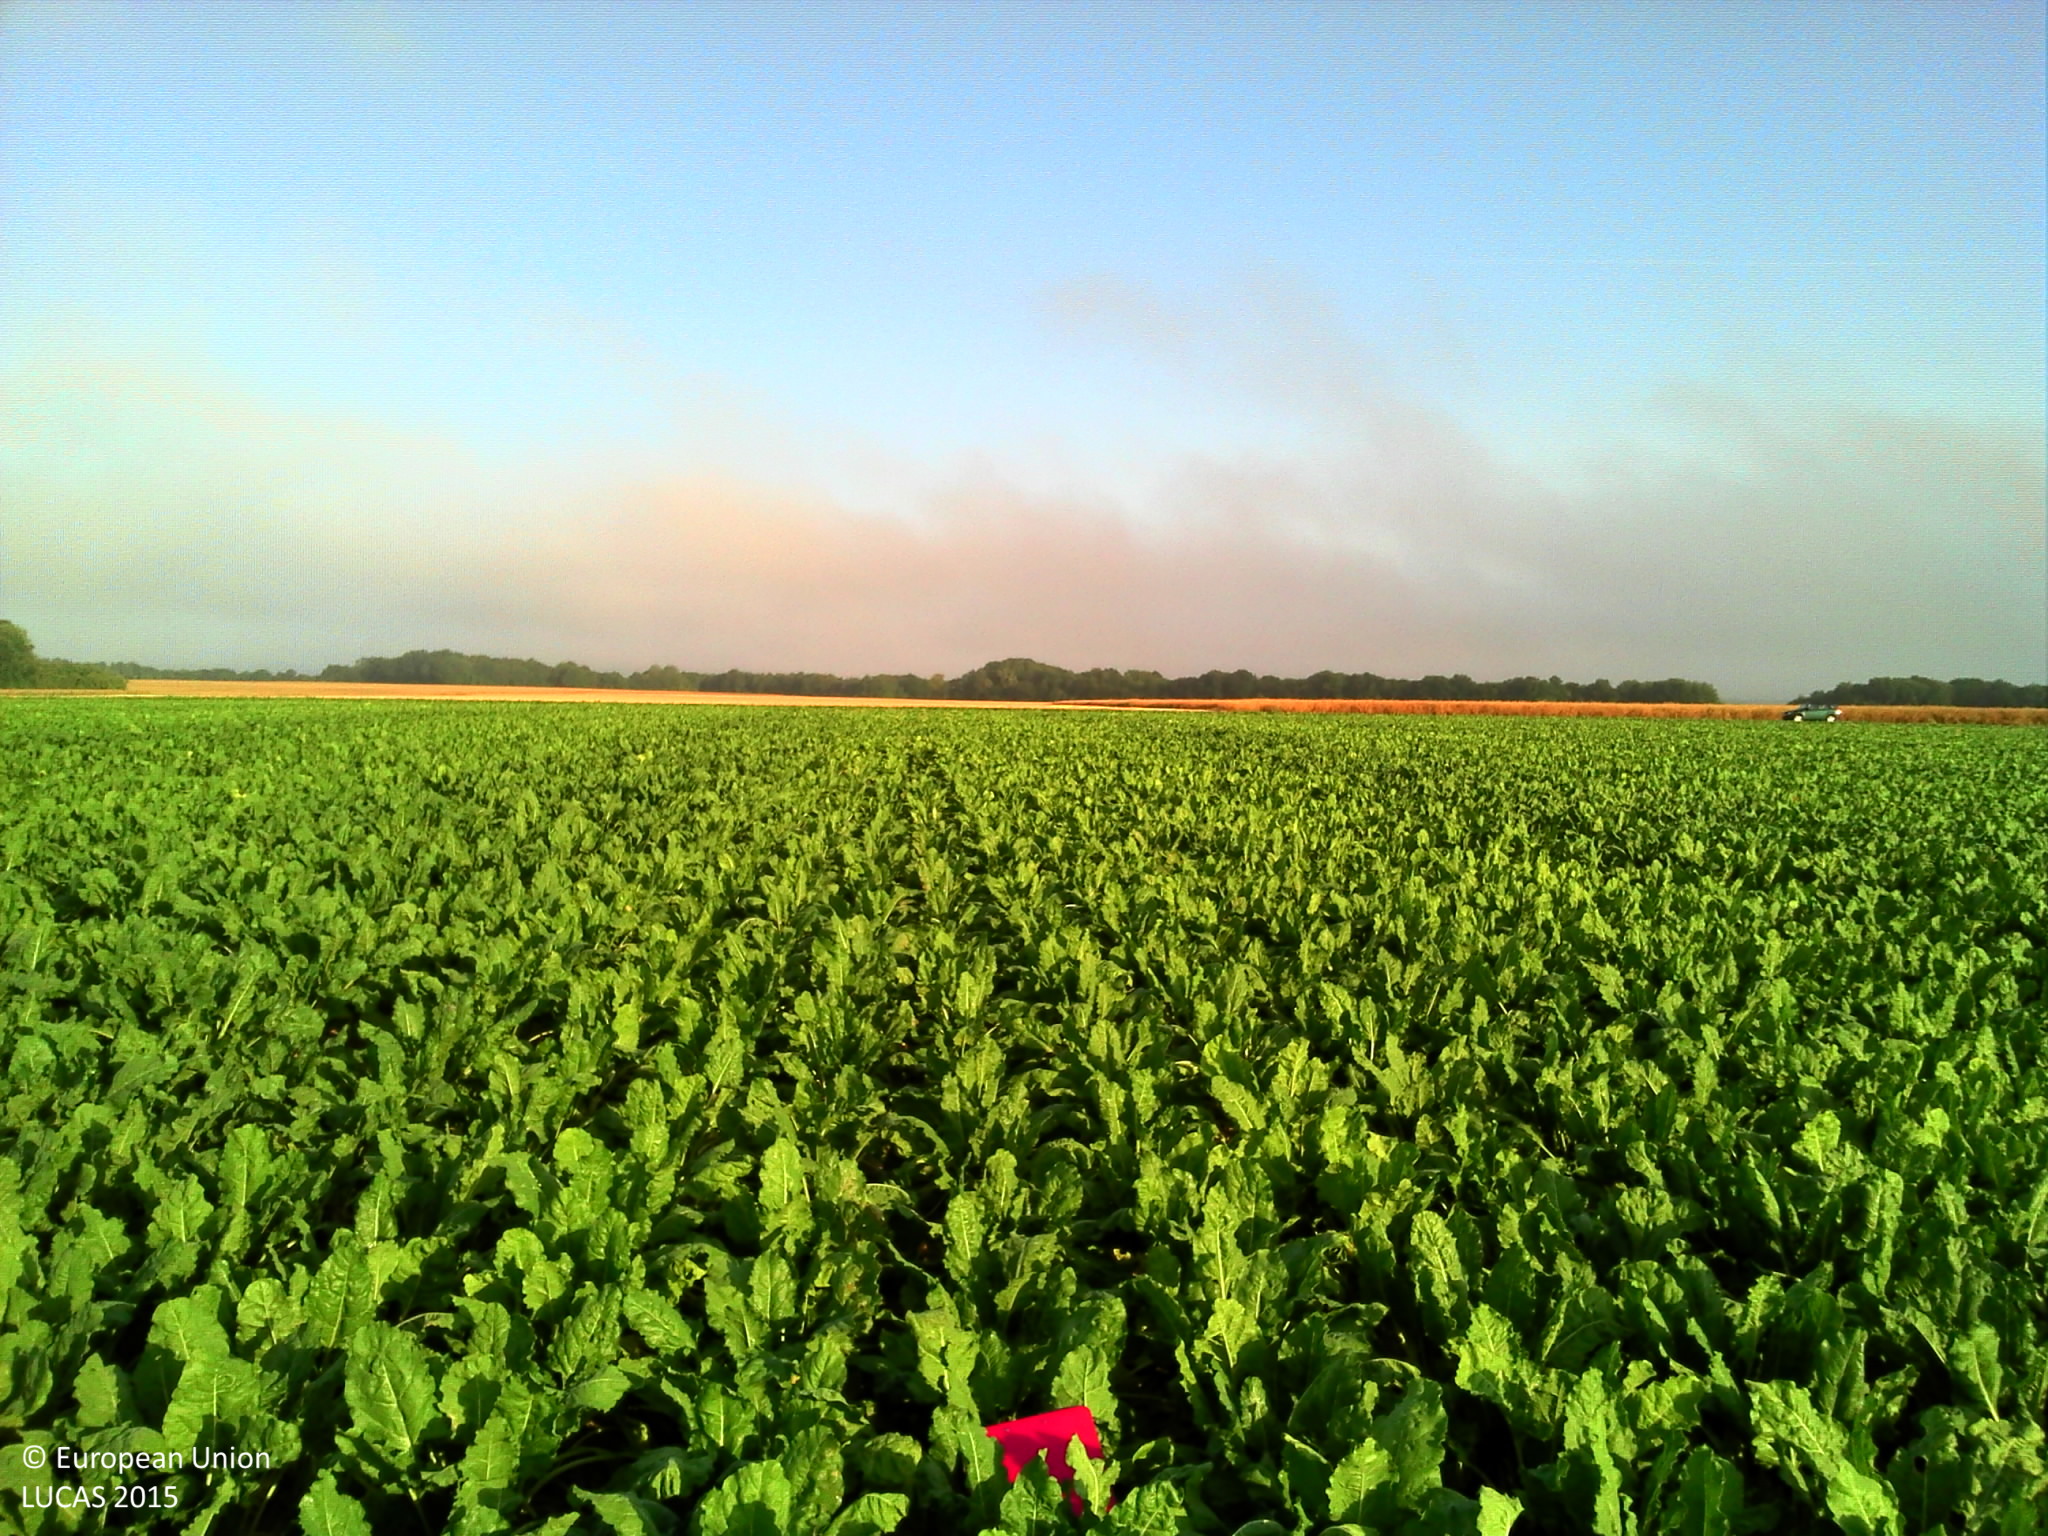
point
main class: Cropland
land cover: Sugar beet
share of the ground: > 75 %
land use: Agriculture (excluding fallow land and kitchen gardens)
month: July
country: FR
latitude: 49.3488
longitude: 2.3474
